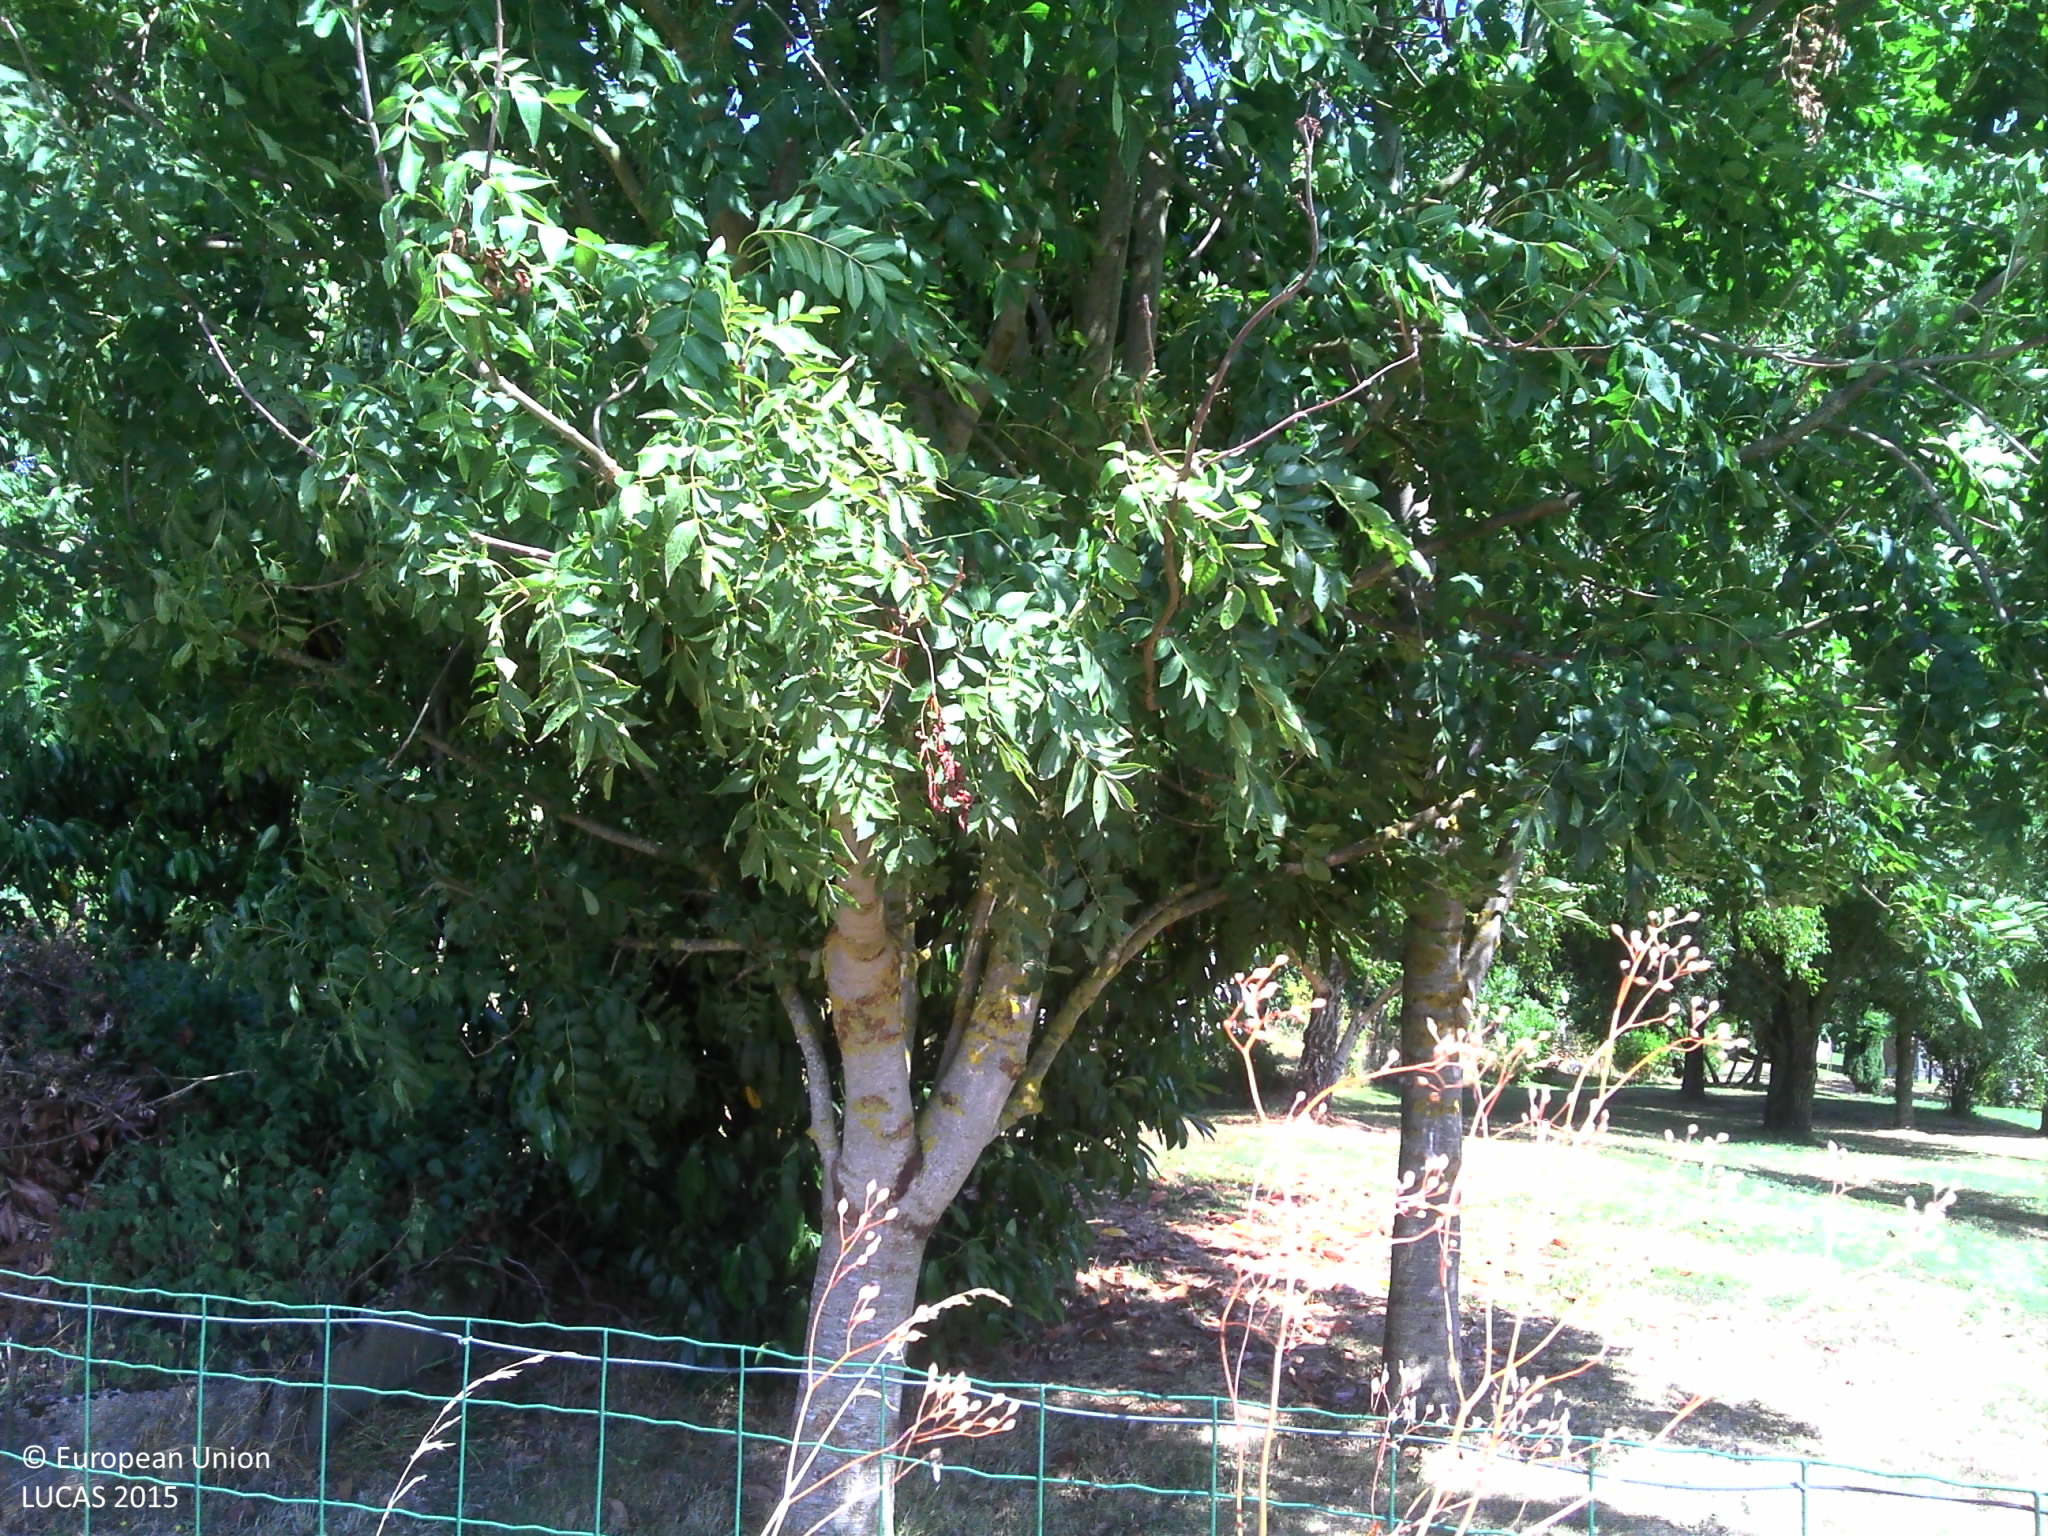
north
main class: Grassland
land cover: Grassland with sparse tree/shrub cover
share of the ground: > 75 %
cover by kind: herbaceous plants 85 %, broadleaved forest trees 5 %, consolidated bare surface 5 %
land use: Residential
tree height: < 5 m
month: August
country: FR
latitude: 48.8502
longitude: 3.3013
